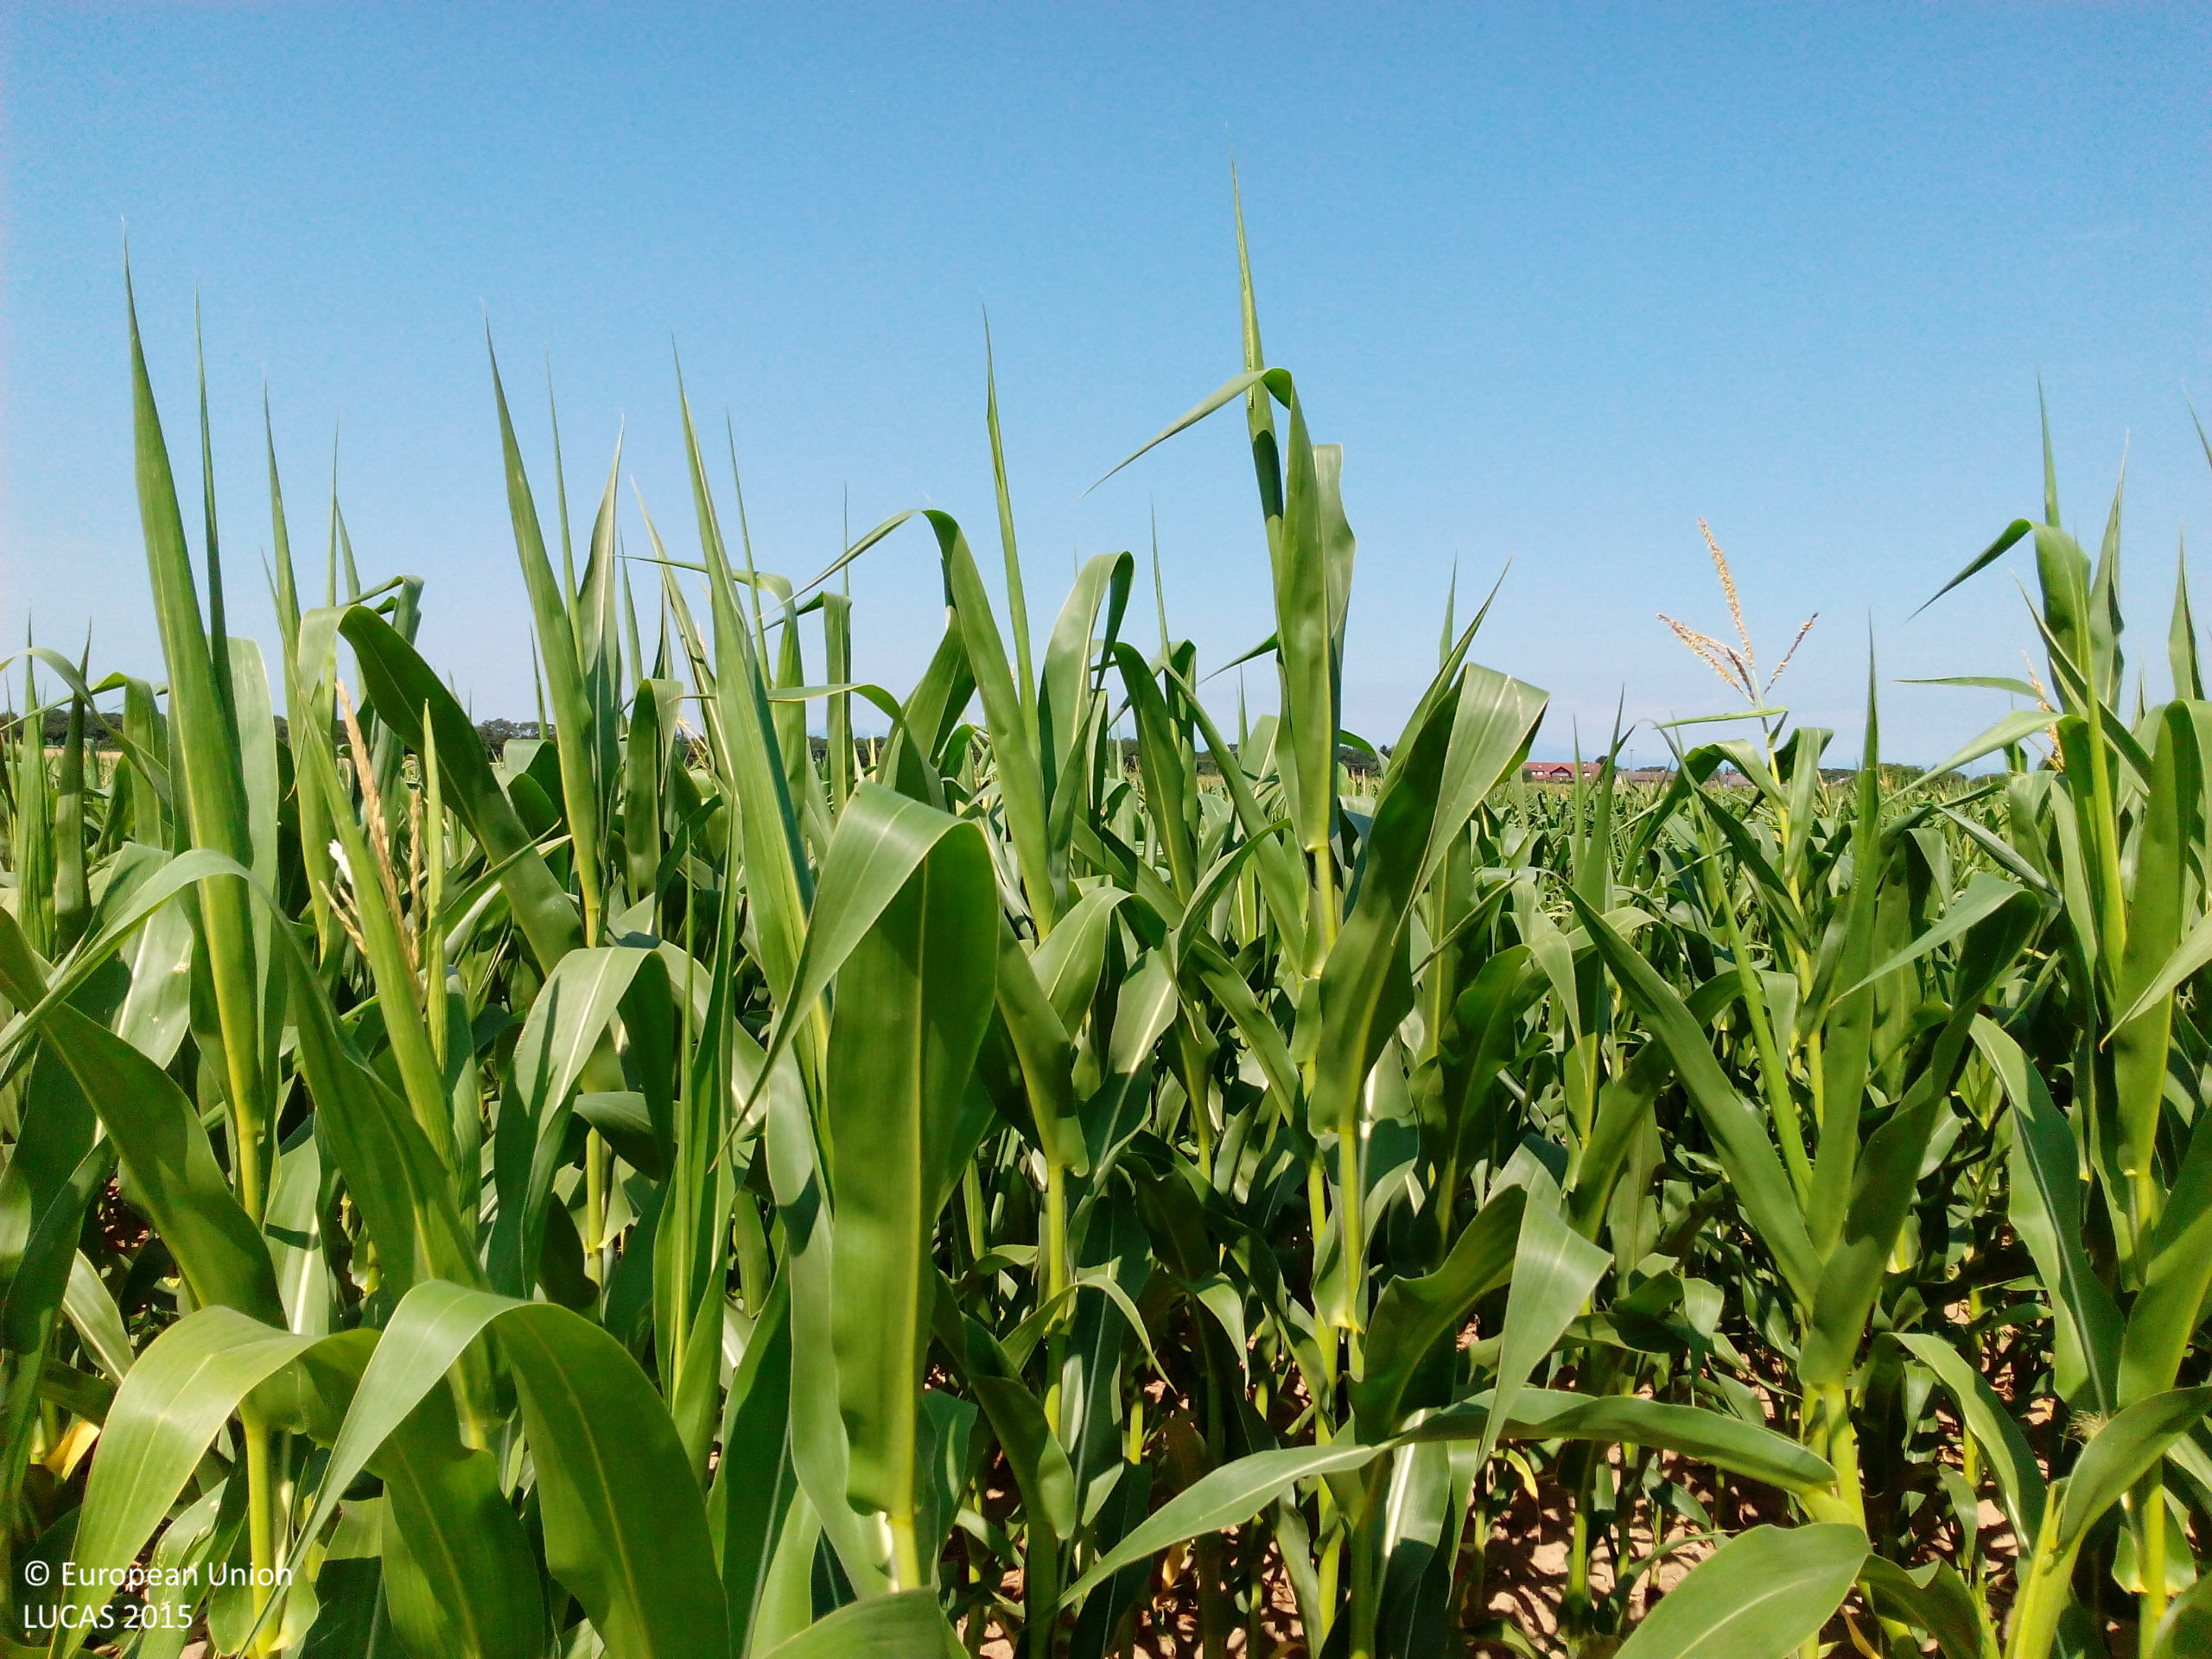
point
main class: Cropland
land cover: Maize
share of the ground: > 75 %
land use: Agriculture (excluding fallow land and kitchen gardens)
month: July
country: DE
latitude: 47.8370
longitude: 7.5831
